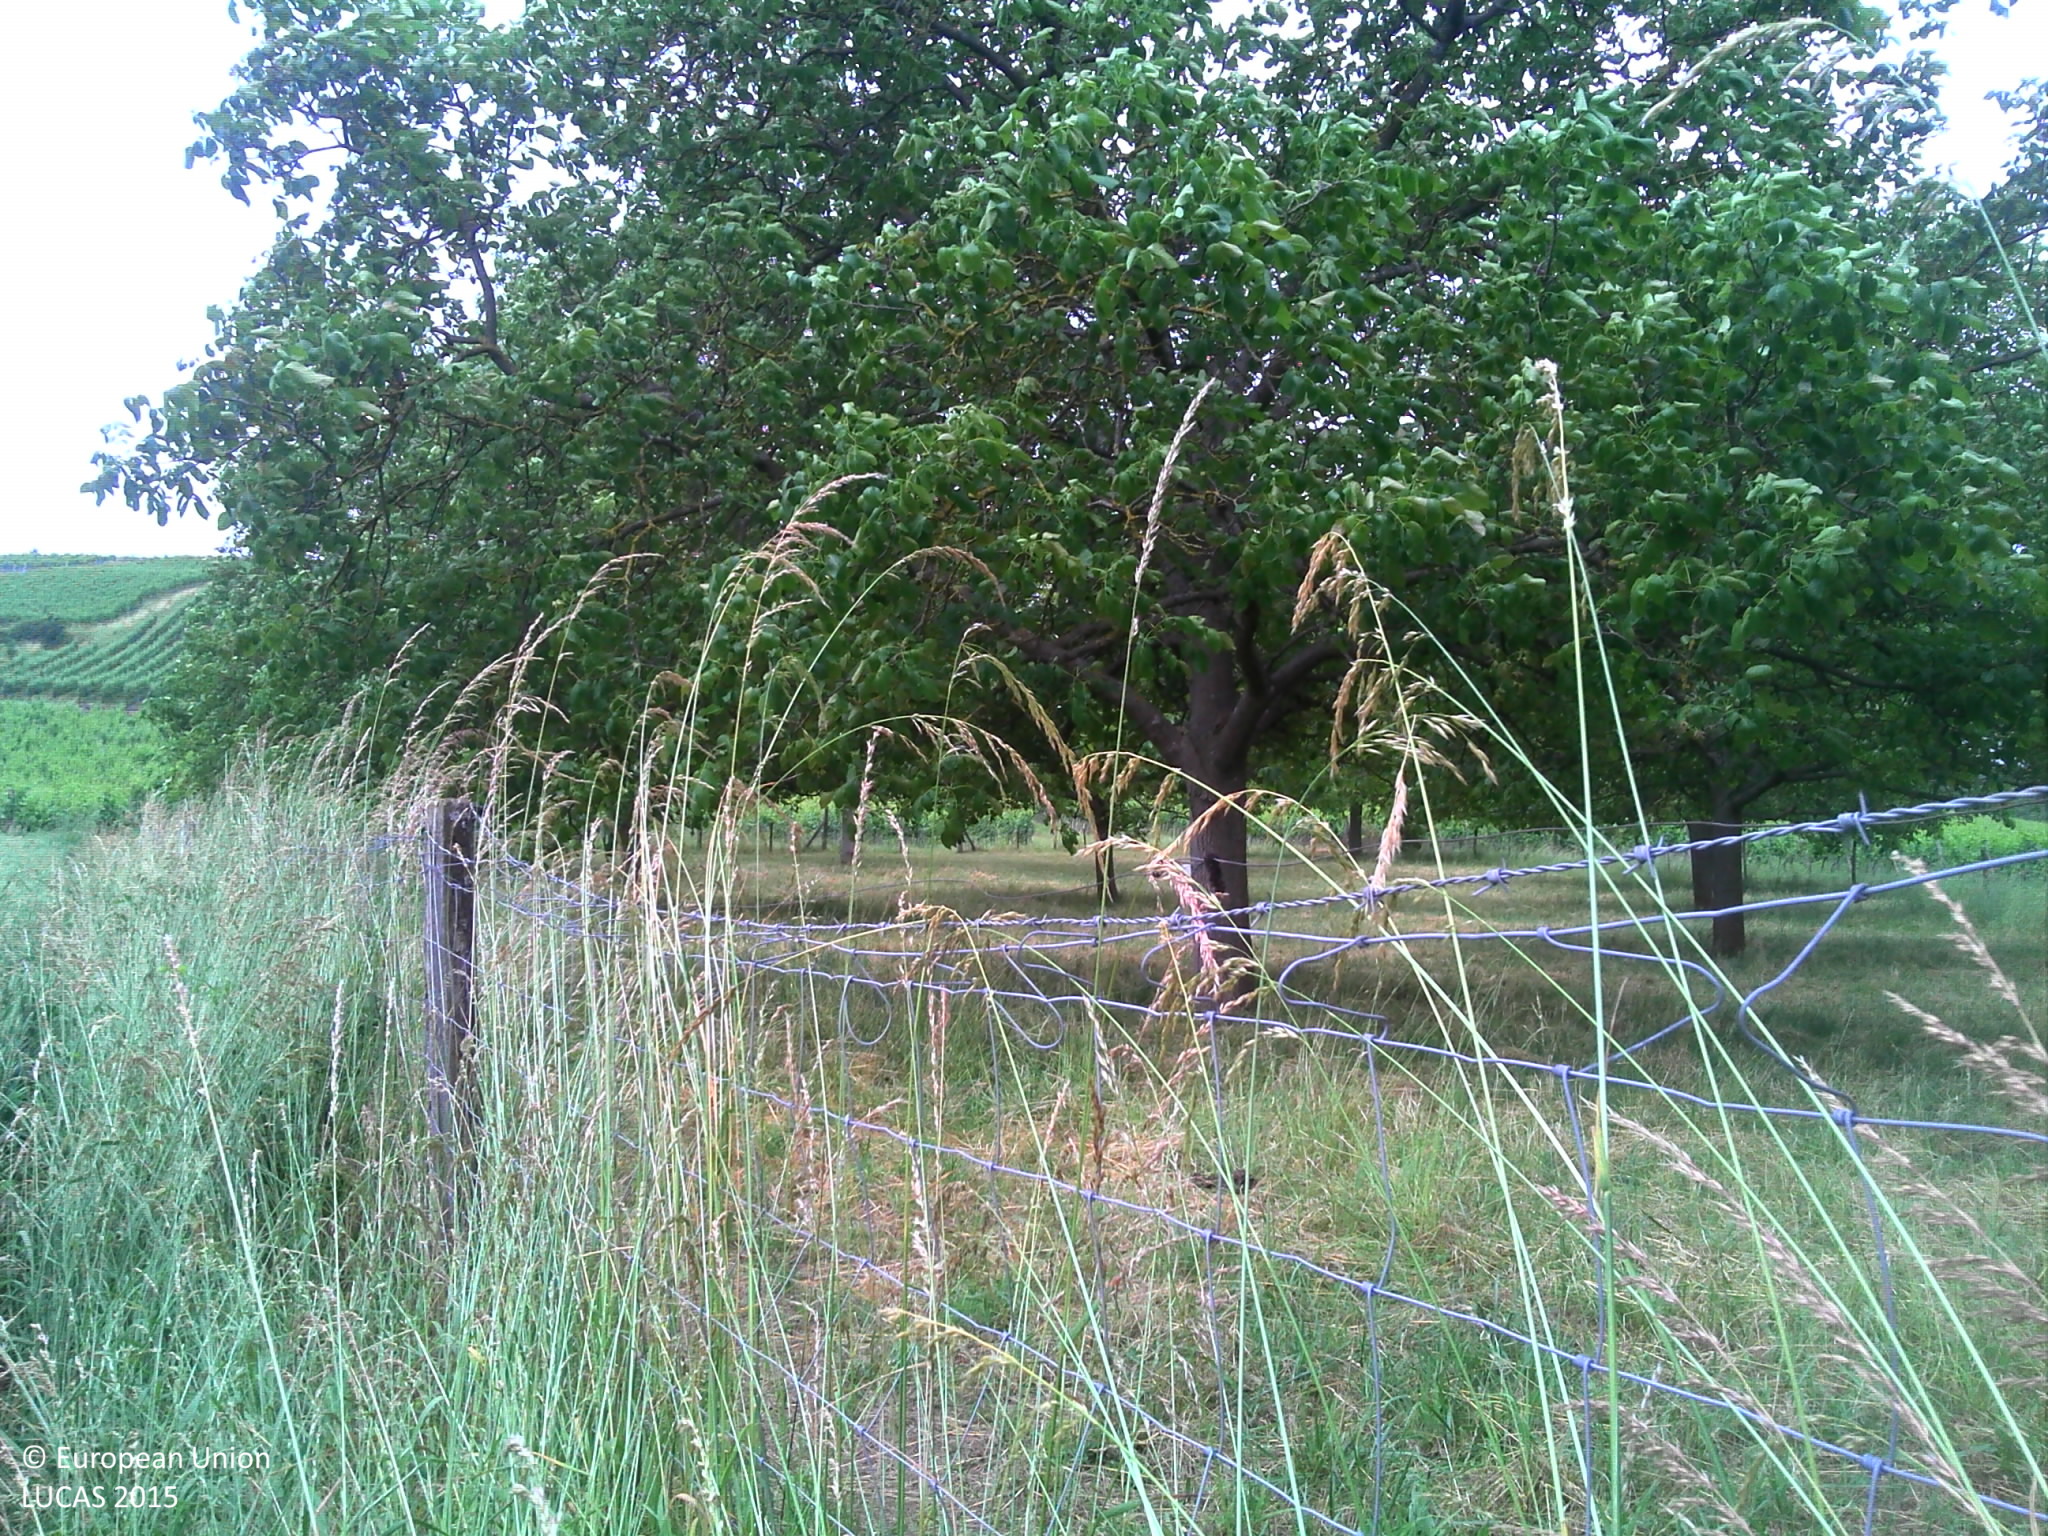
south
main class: Cropland
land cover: Nuts trees
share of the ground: > 75 %
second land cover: Grassland without tree/shrub cover
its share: > 75 %
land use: Agriculture (excluding fallow land and kitchen gardens)
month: June
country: FR
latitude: 48.5186
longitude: 7.4691
